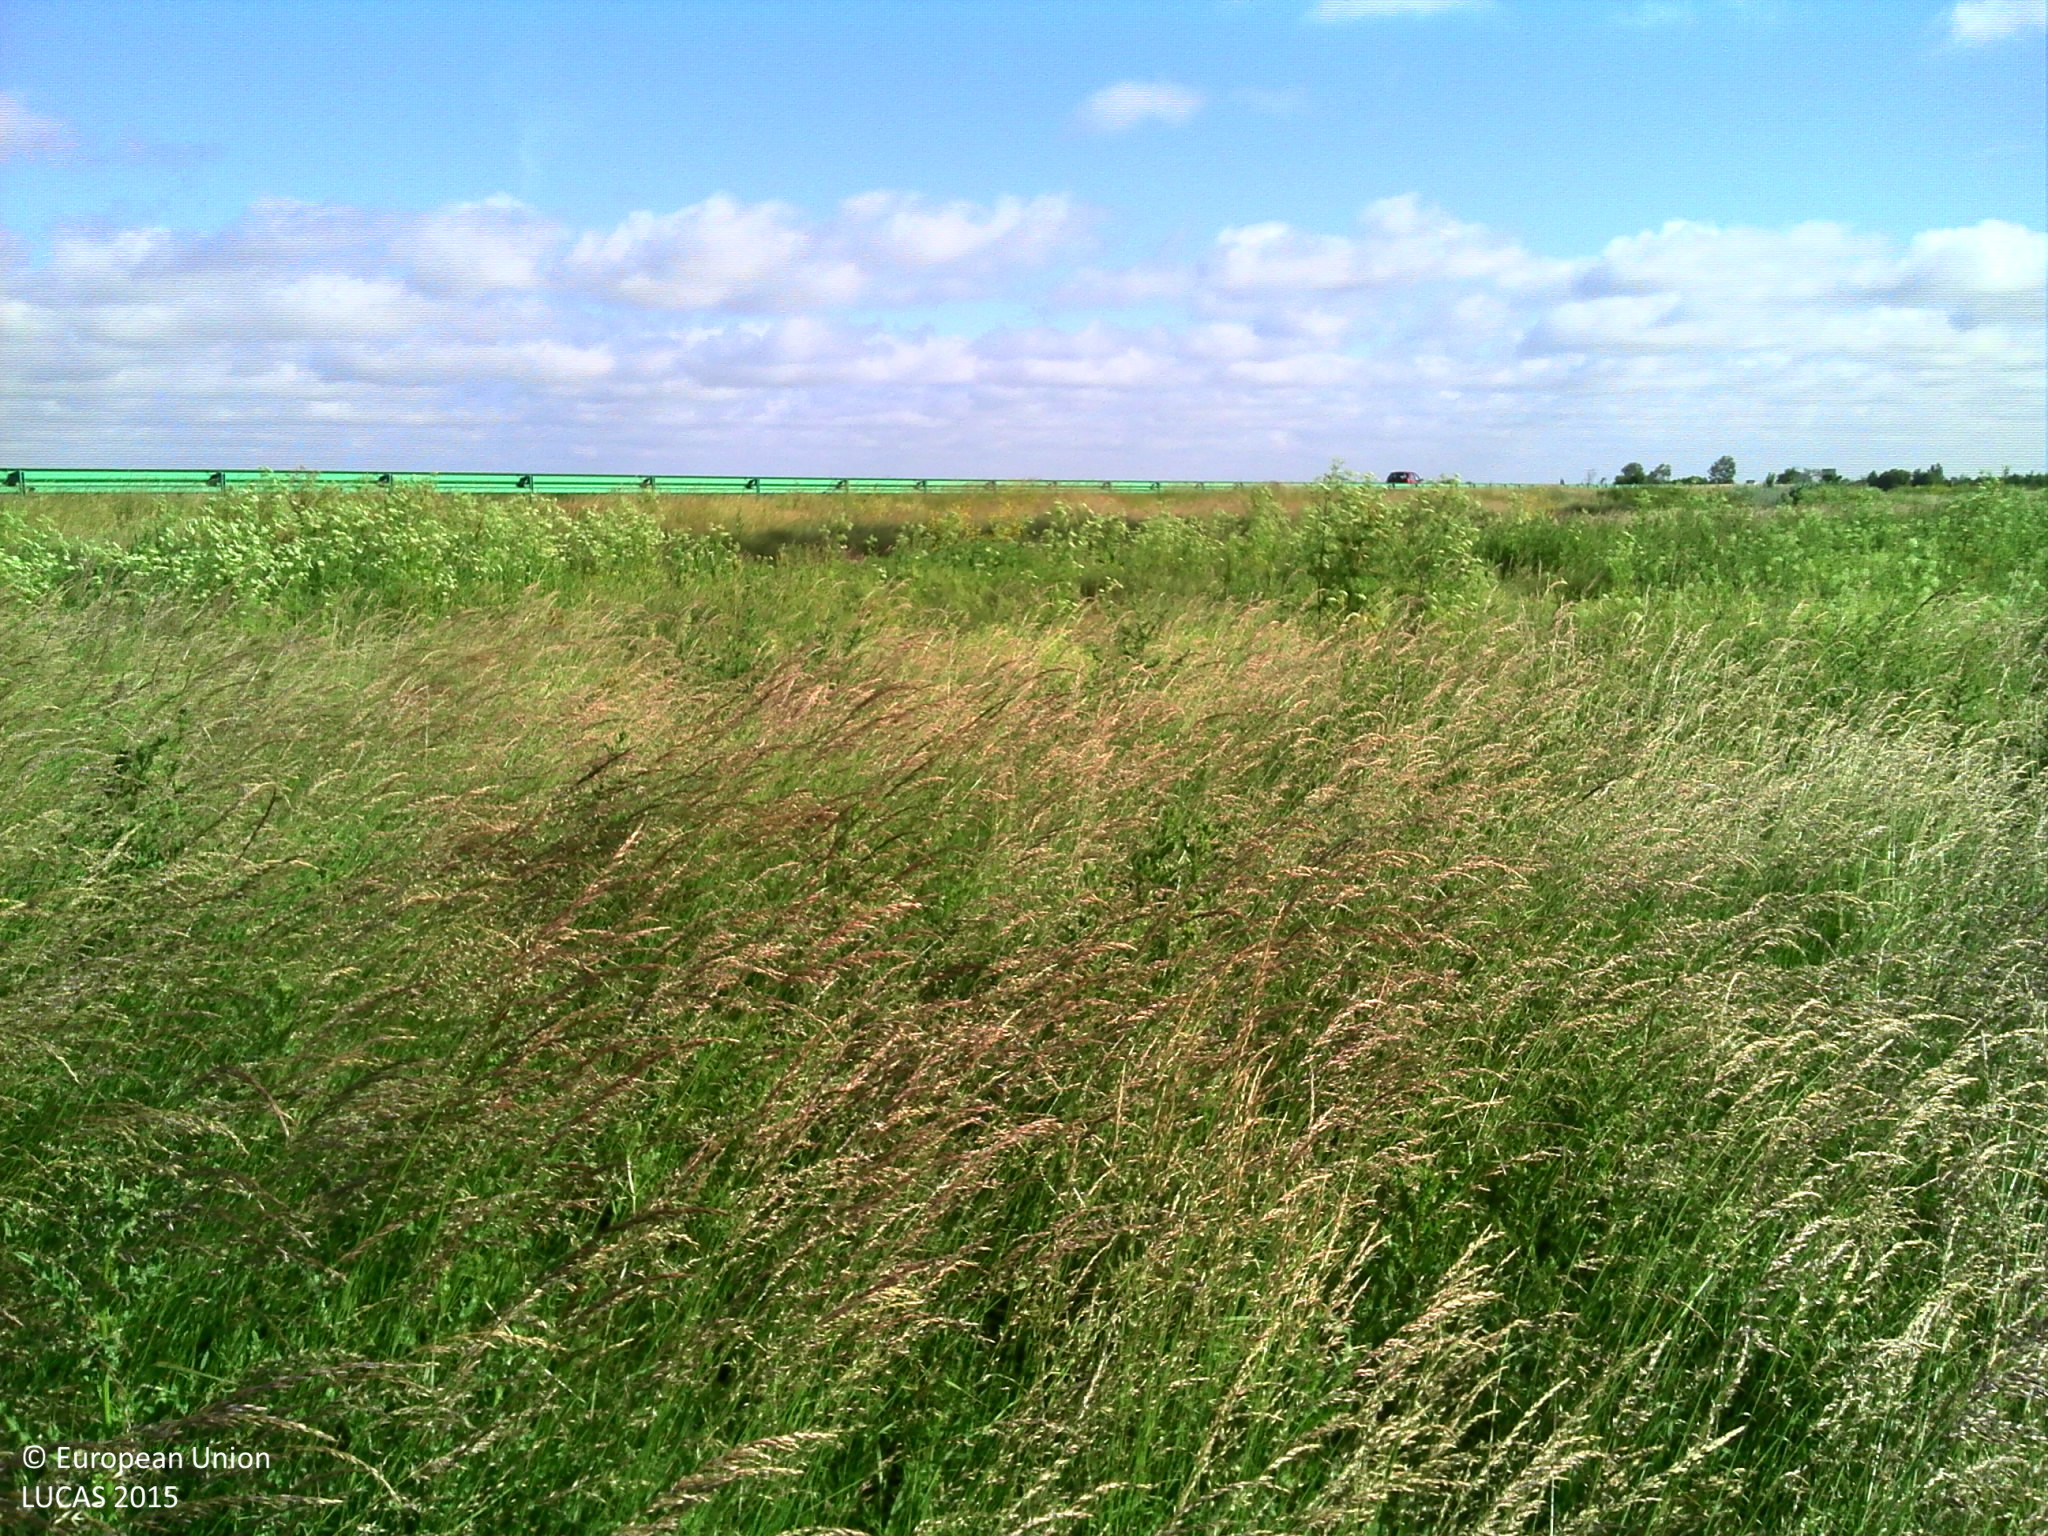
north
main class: Grassland
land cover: Grassland without tree/shrub cover
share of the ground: > 75 %
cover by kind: herbaceous plants 100 %
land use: Agriculture (excluding fallow land and kitchen gardens)
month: June
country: FR
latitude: 46.2473
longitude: -1.0691
